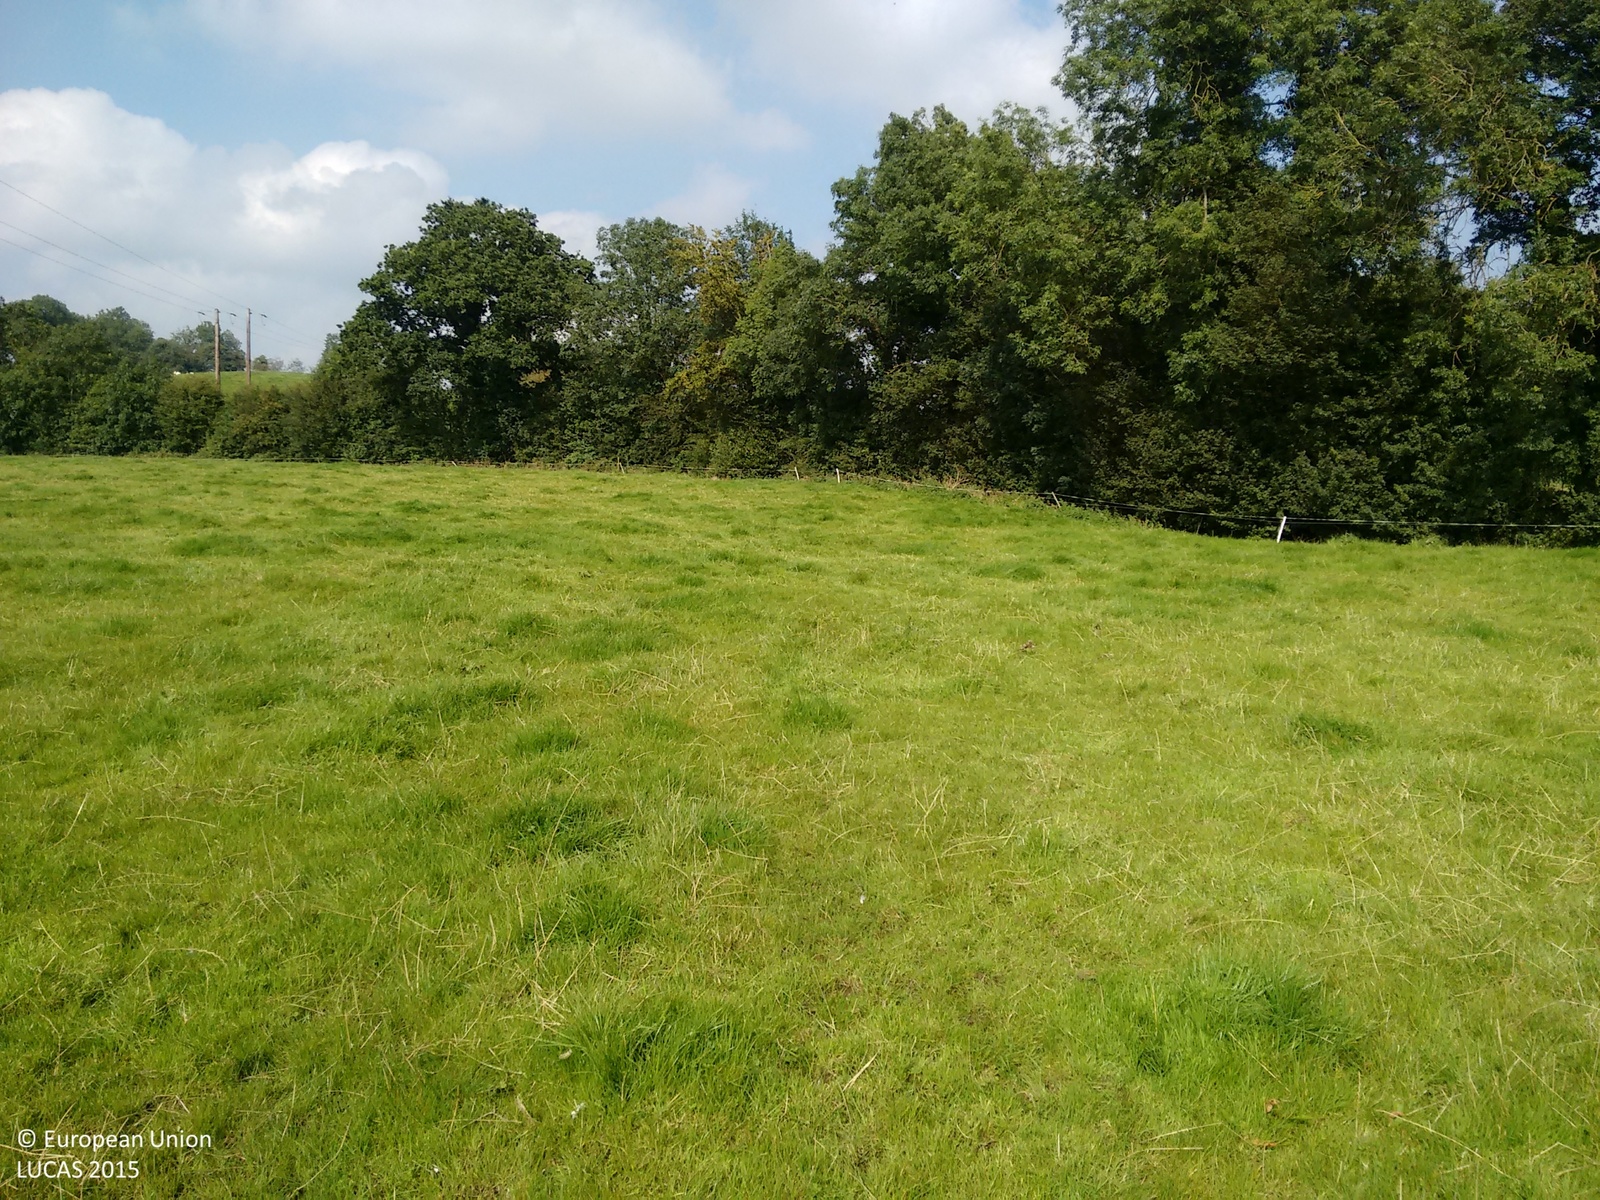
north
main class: Grassland
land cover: Grassland without tree/shrub cover
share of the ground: > 75 %
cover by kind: herbaceous plants 100 %
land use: Agriculture (excluding fallow land and kitchen gardens)
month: September
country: IE
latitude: 54.2690
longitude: -6.9840
